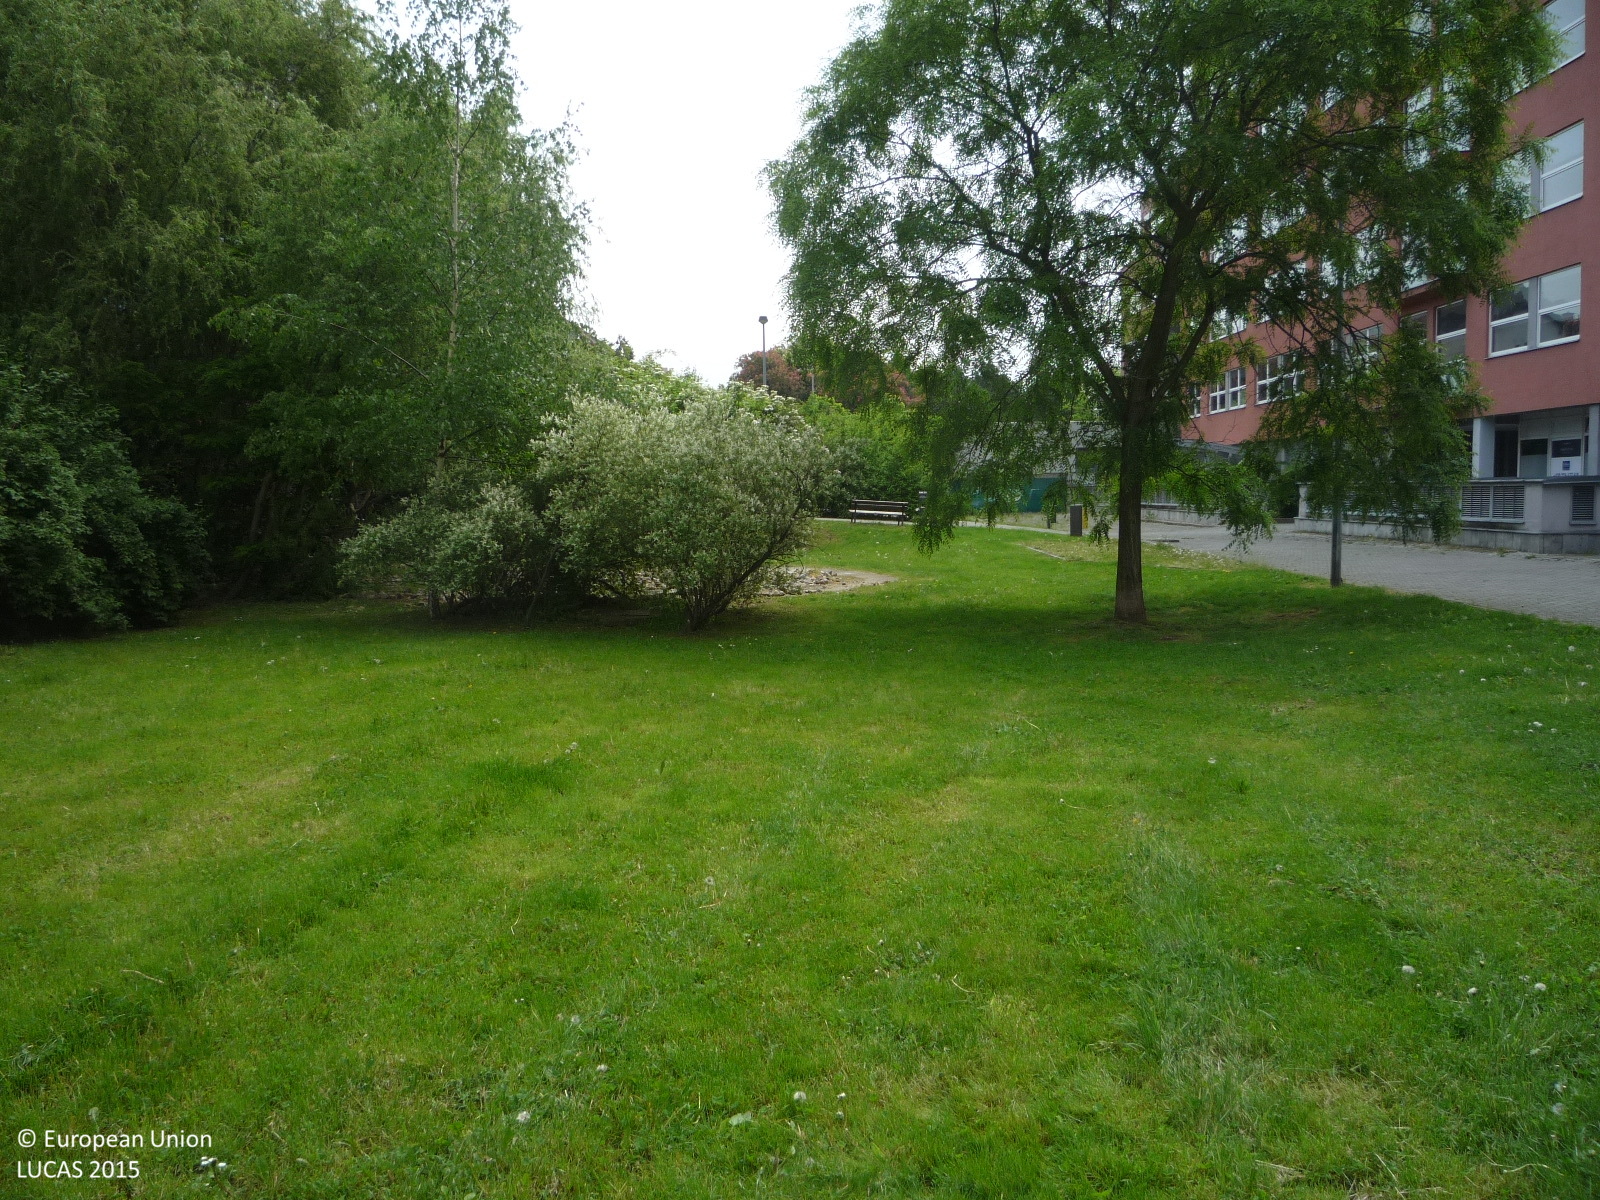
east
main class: Grassland
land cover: Grassland with sparse tree/shrub cover
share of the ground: > 75 %
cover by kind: herbaceous plants 90 %, broadleaved forest trees 5 %, shrubs 5 %
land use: Residential
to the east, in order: Grassland with sparse tree/shrub cover; Artificial constructions in urban areas
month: May
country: CZ
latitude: 50.0780
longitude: 14.4873
